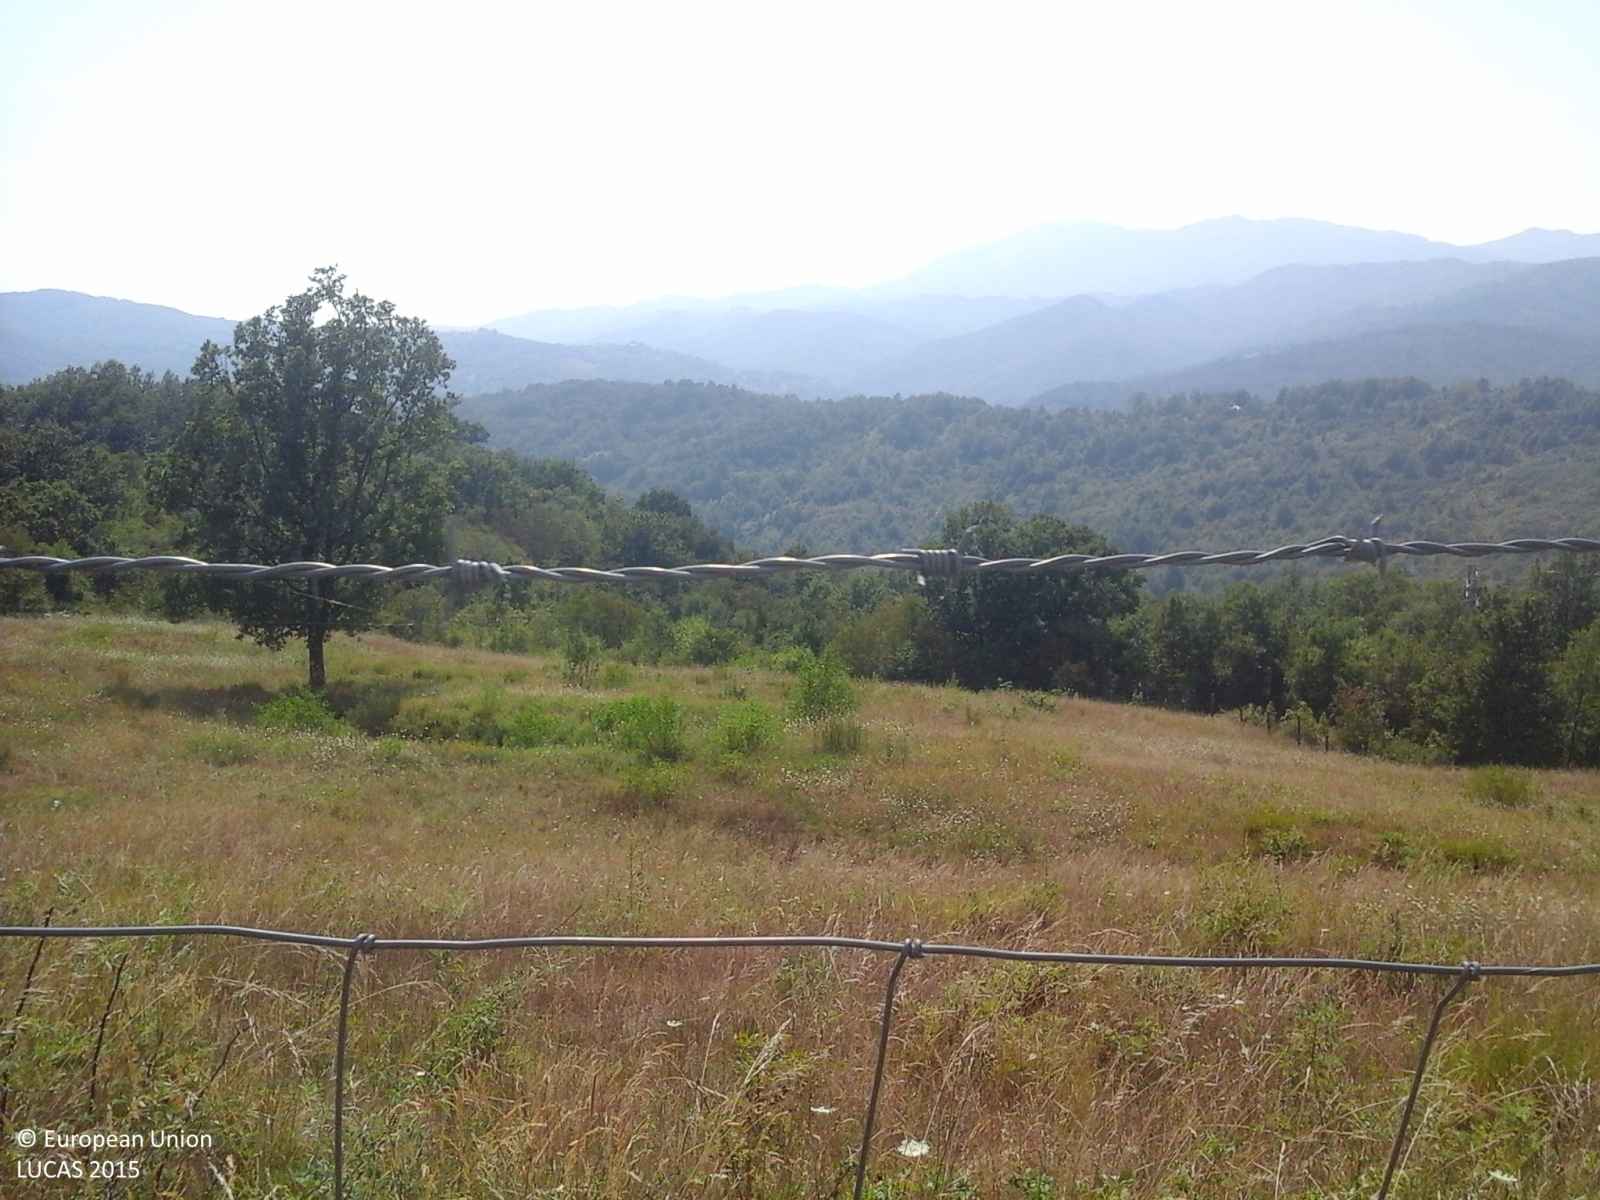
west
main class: Grassland
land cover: Grassland without tree/shrub cover
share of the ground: > 75 %
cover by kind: herbaceous plants 95 %, shrubs 5 %
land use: Semi-natural and natural areas not in use
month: August
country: IT
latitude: 44.3498
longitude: 9.6120
